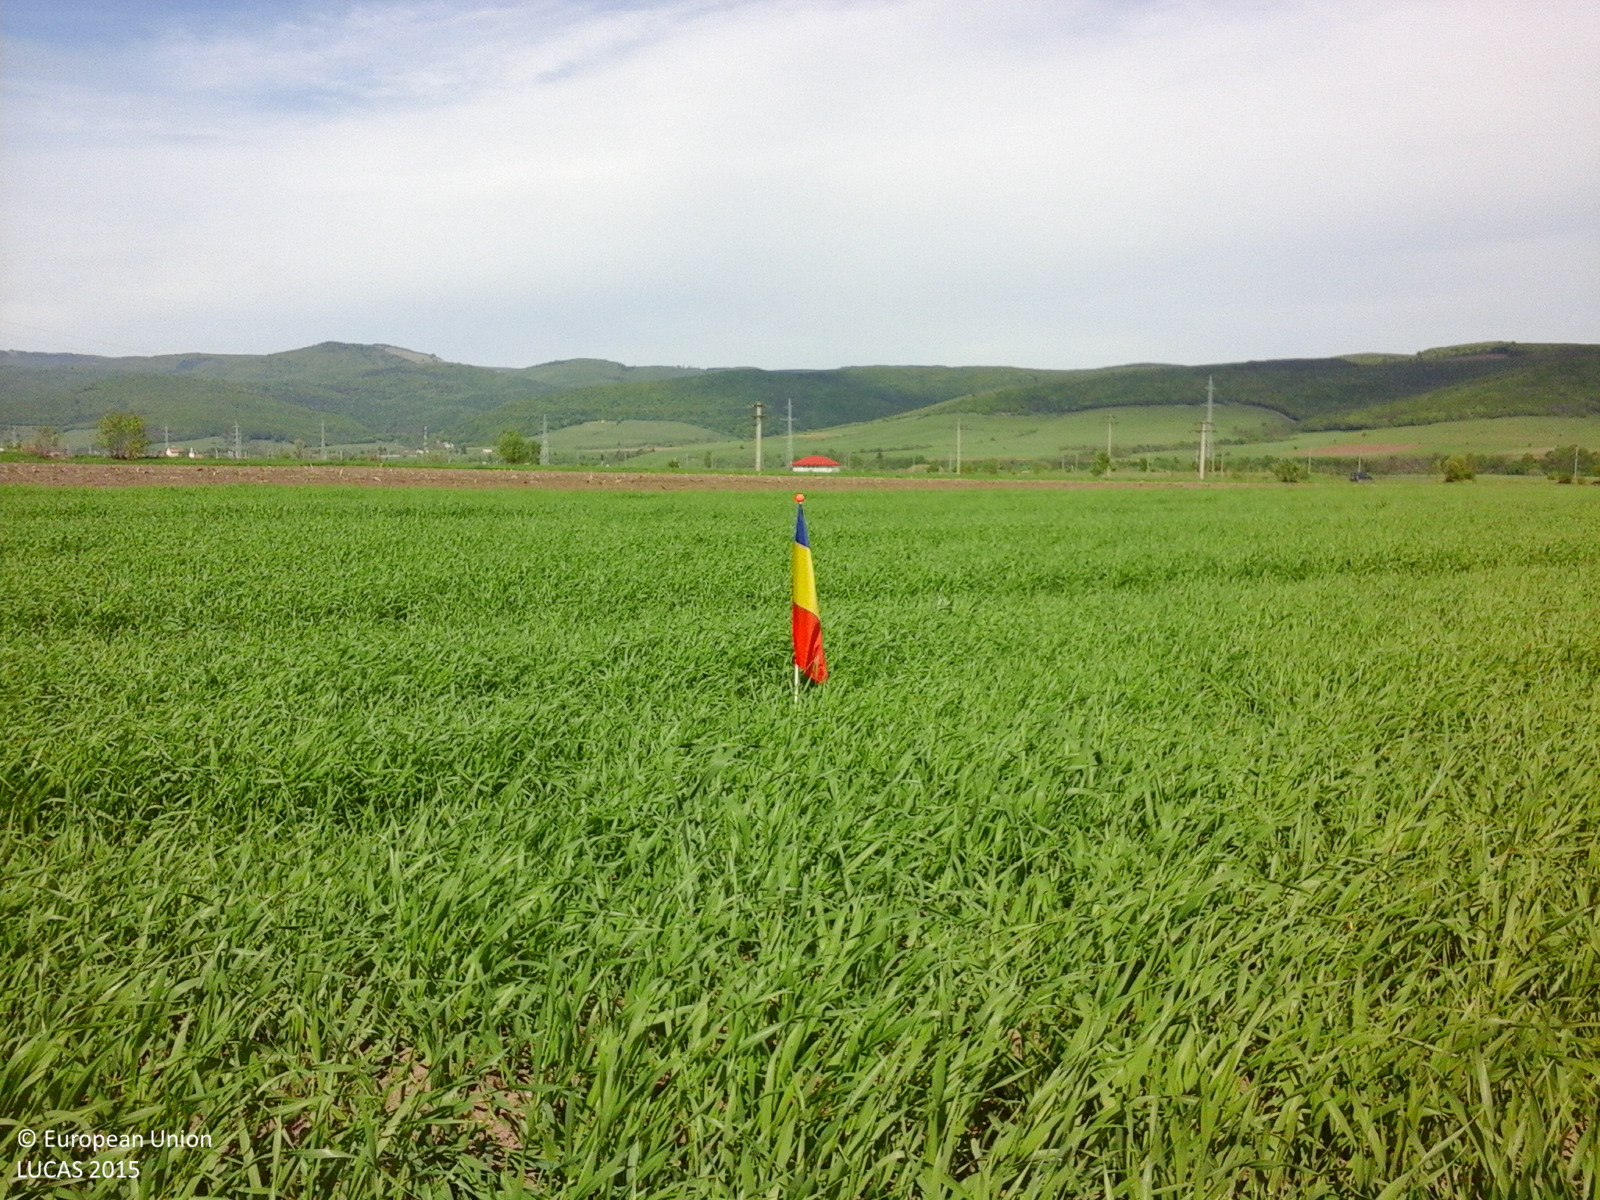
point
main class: Cropland
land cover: Common wheat
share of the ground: > 75 %
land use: Agriculture (excluding fallow land and kitchen gardens)
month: May
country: RO
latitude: 45.9327
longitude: 25.8336
